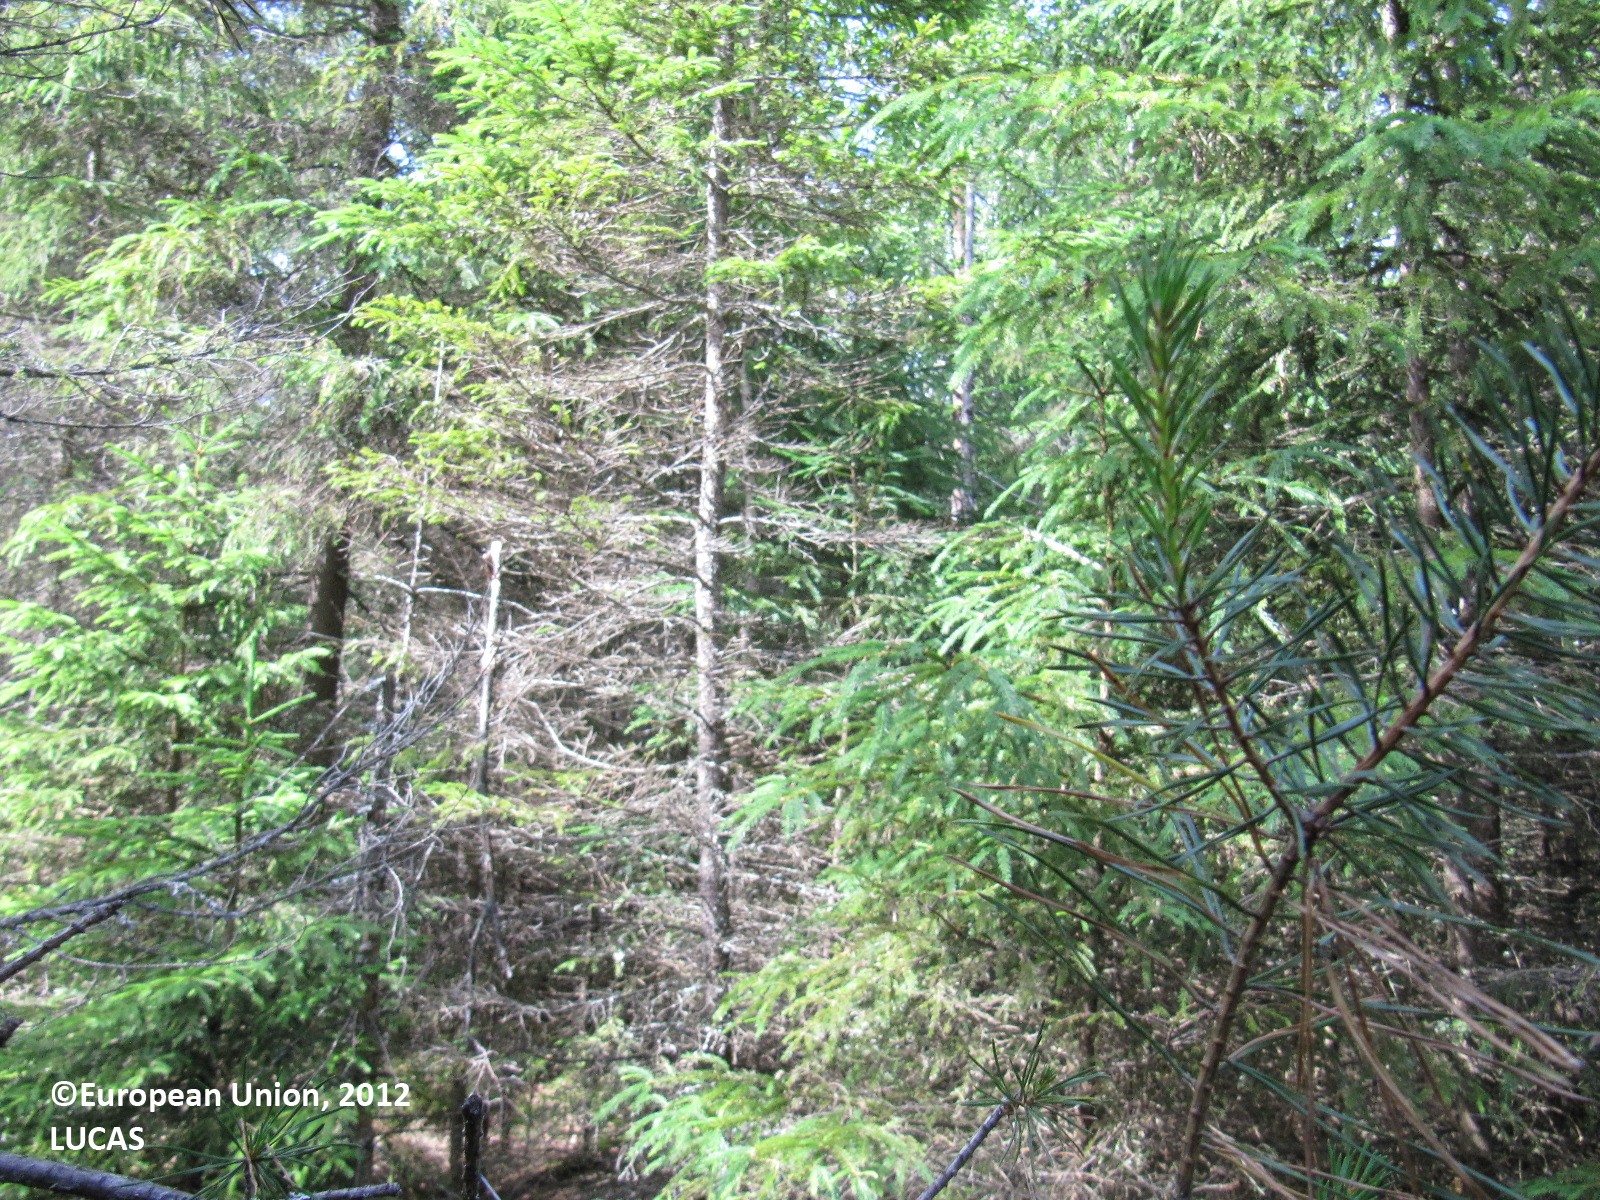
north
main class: Woodland
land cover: Spruce dominated mixed woodland
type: boreal forest
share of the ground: > 75 %
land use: Forestry
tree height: > 5 m
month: July
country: FI
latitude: 60.8569
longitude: 24.1417
